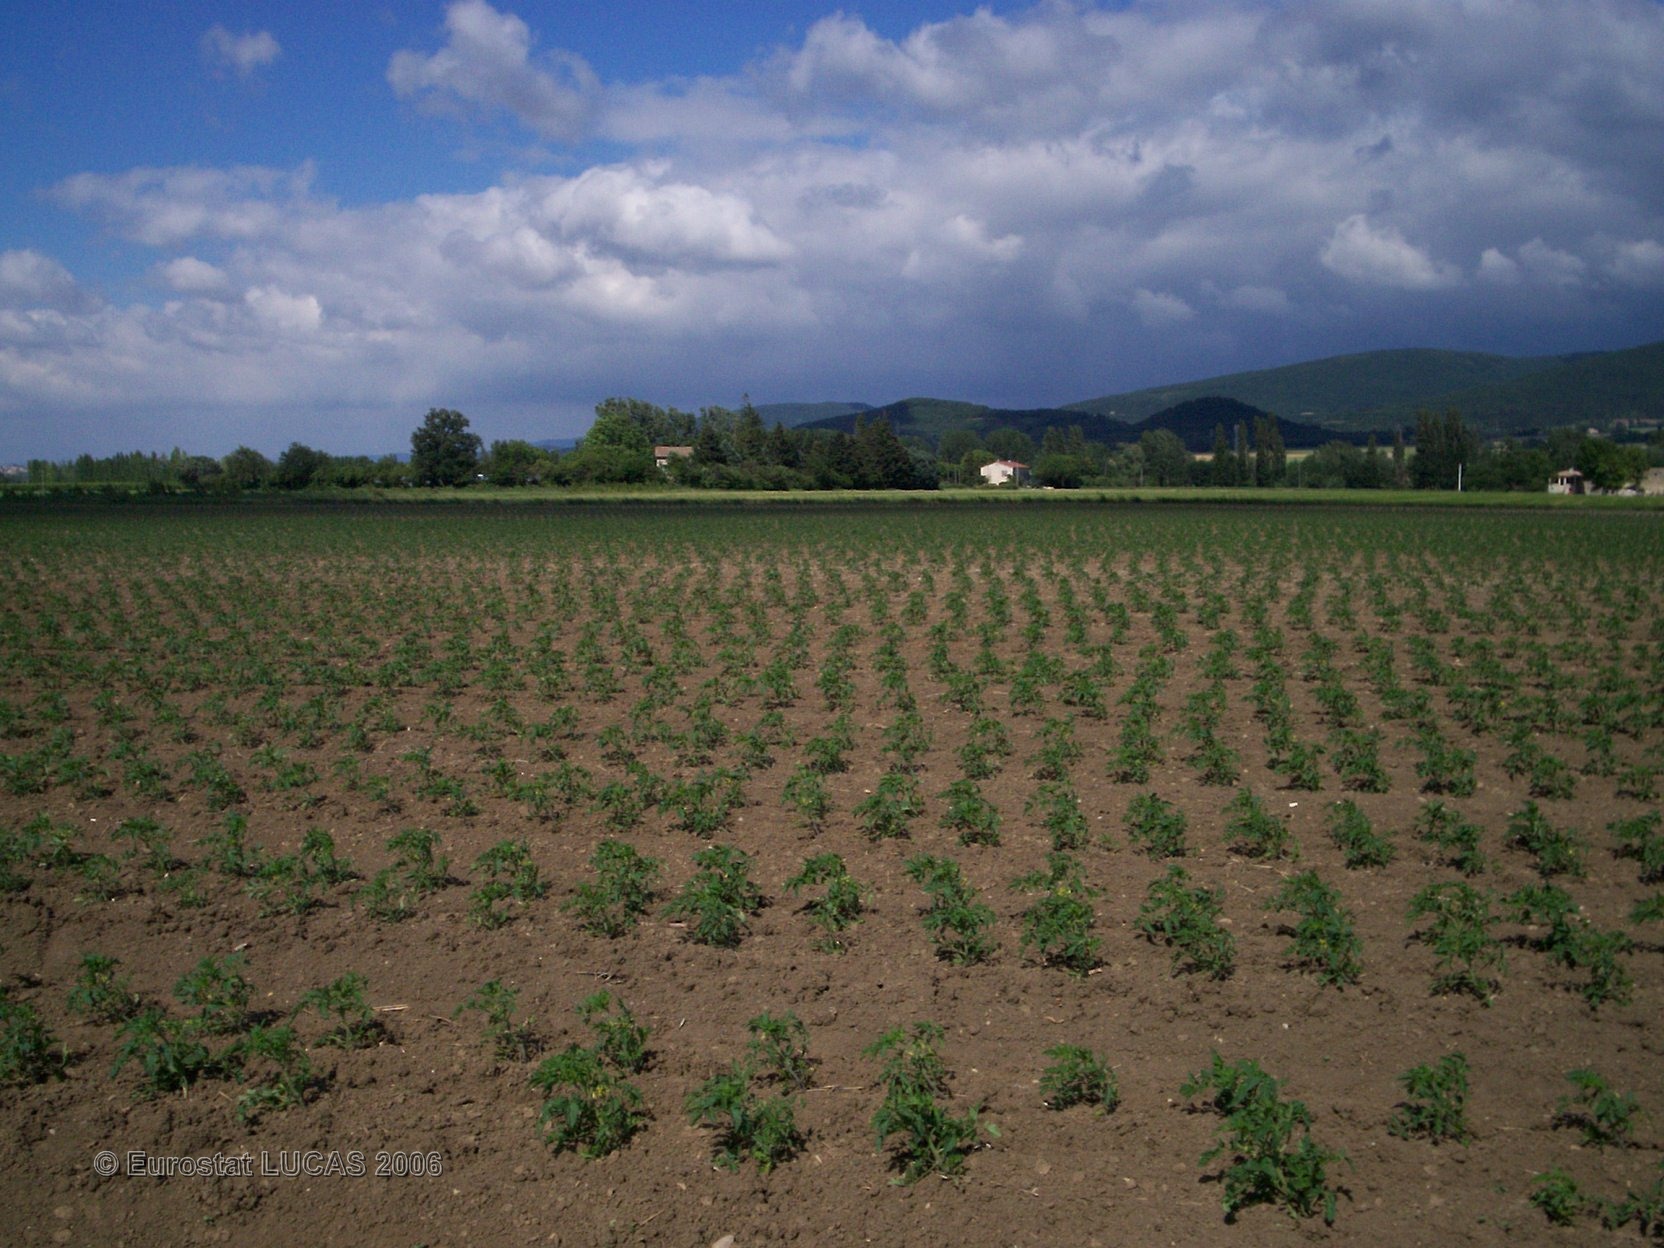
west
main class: Cropland
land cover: Tomatoes
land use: Agriculture (excluding fallow land and kitchen gardens)
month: May
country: FR
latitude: 44.6228
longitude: 4.9022
